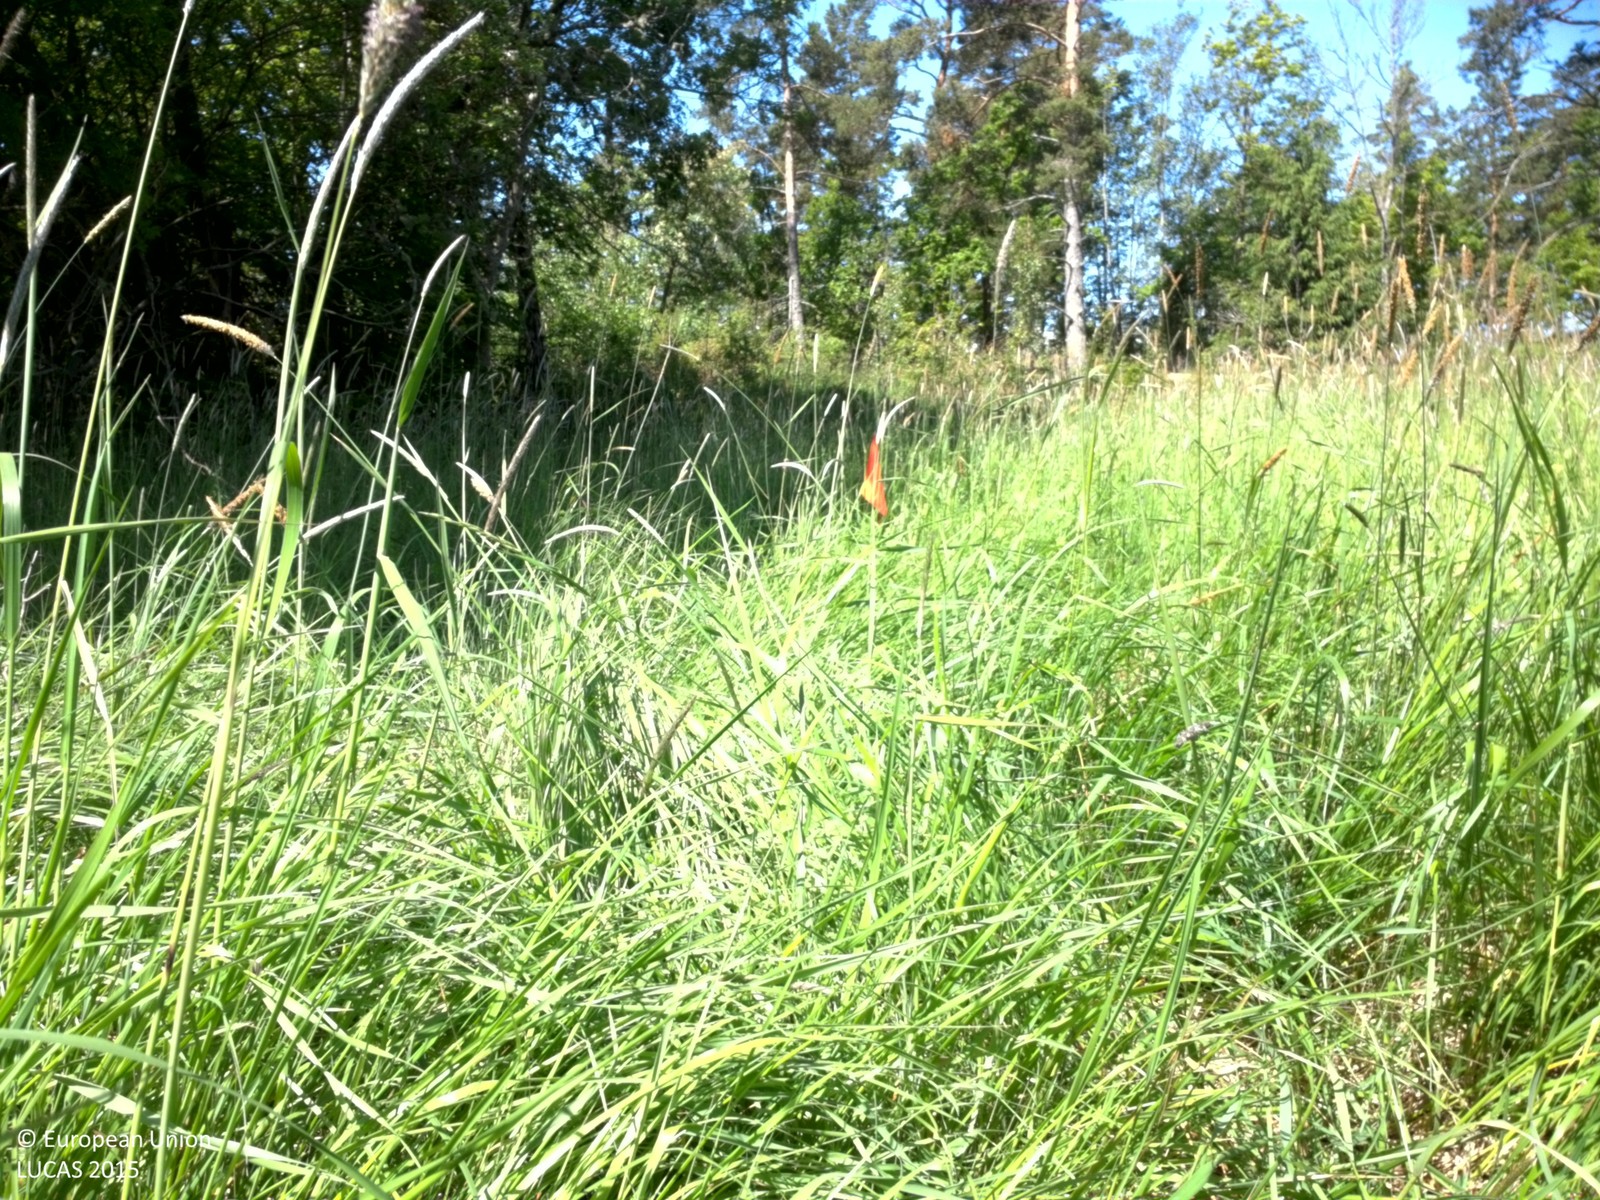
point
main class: Grassland
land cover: Grassland without tree/shrub cover
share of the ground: > 75 %
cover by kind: herbaceous plants 100 %
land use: Semi-natural and natural areas not in use
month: June
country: SE
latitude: 60.1340
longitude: 18.6210
